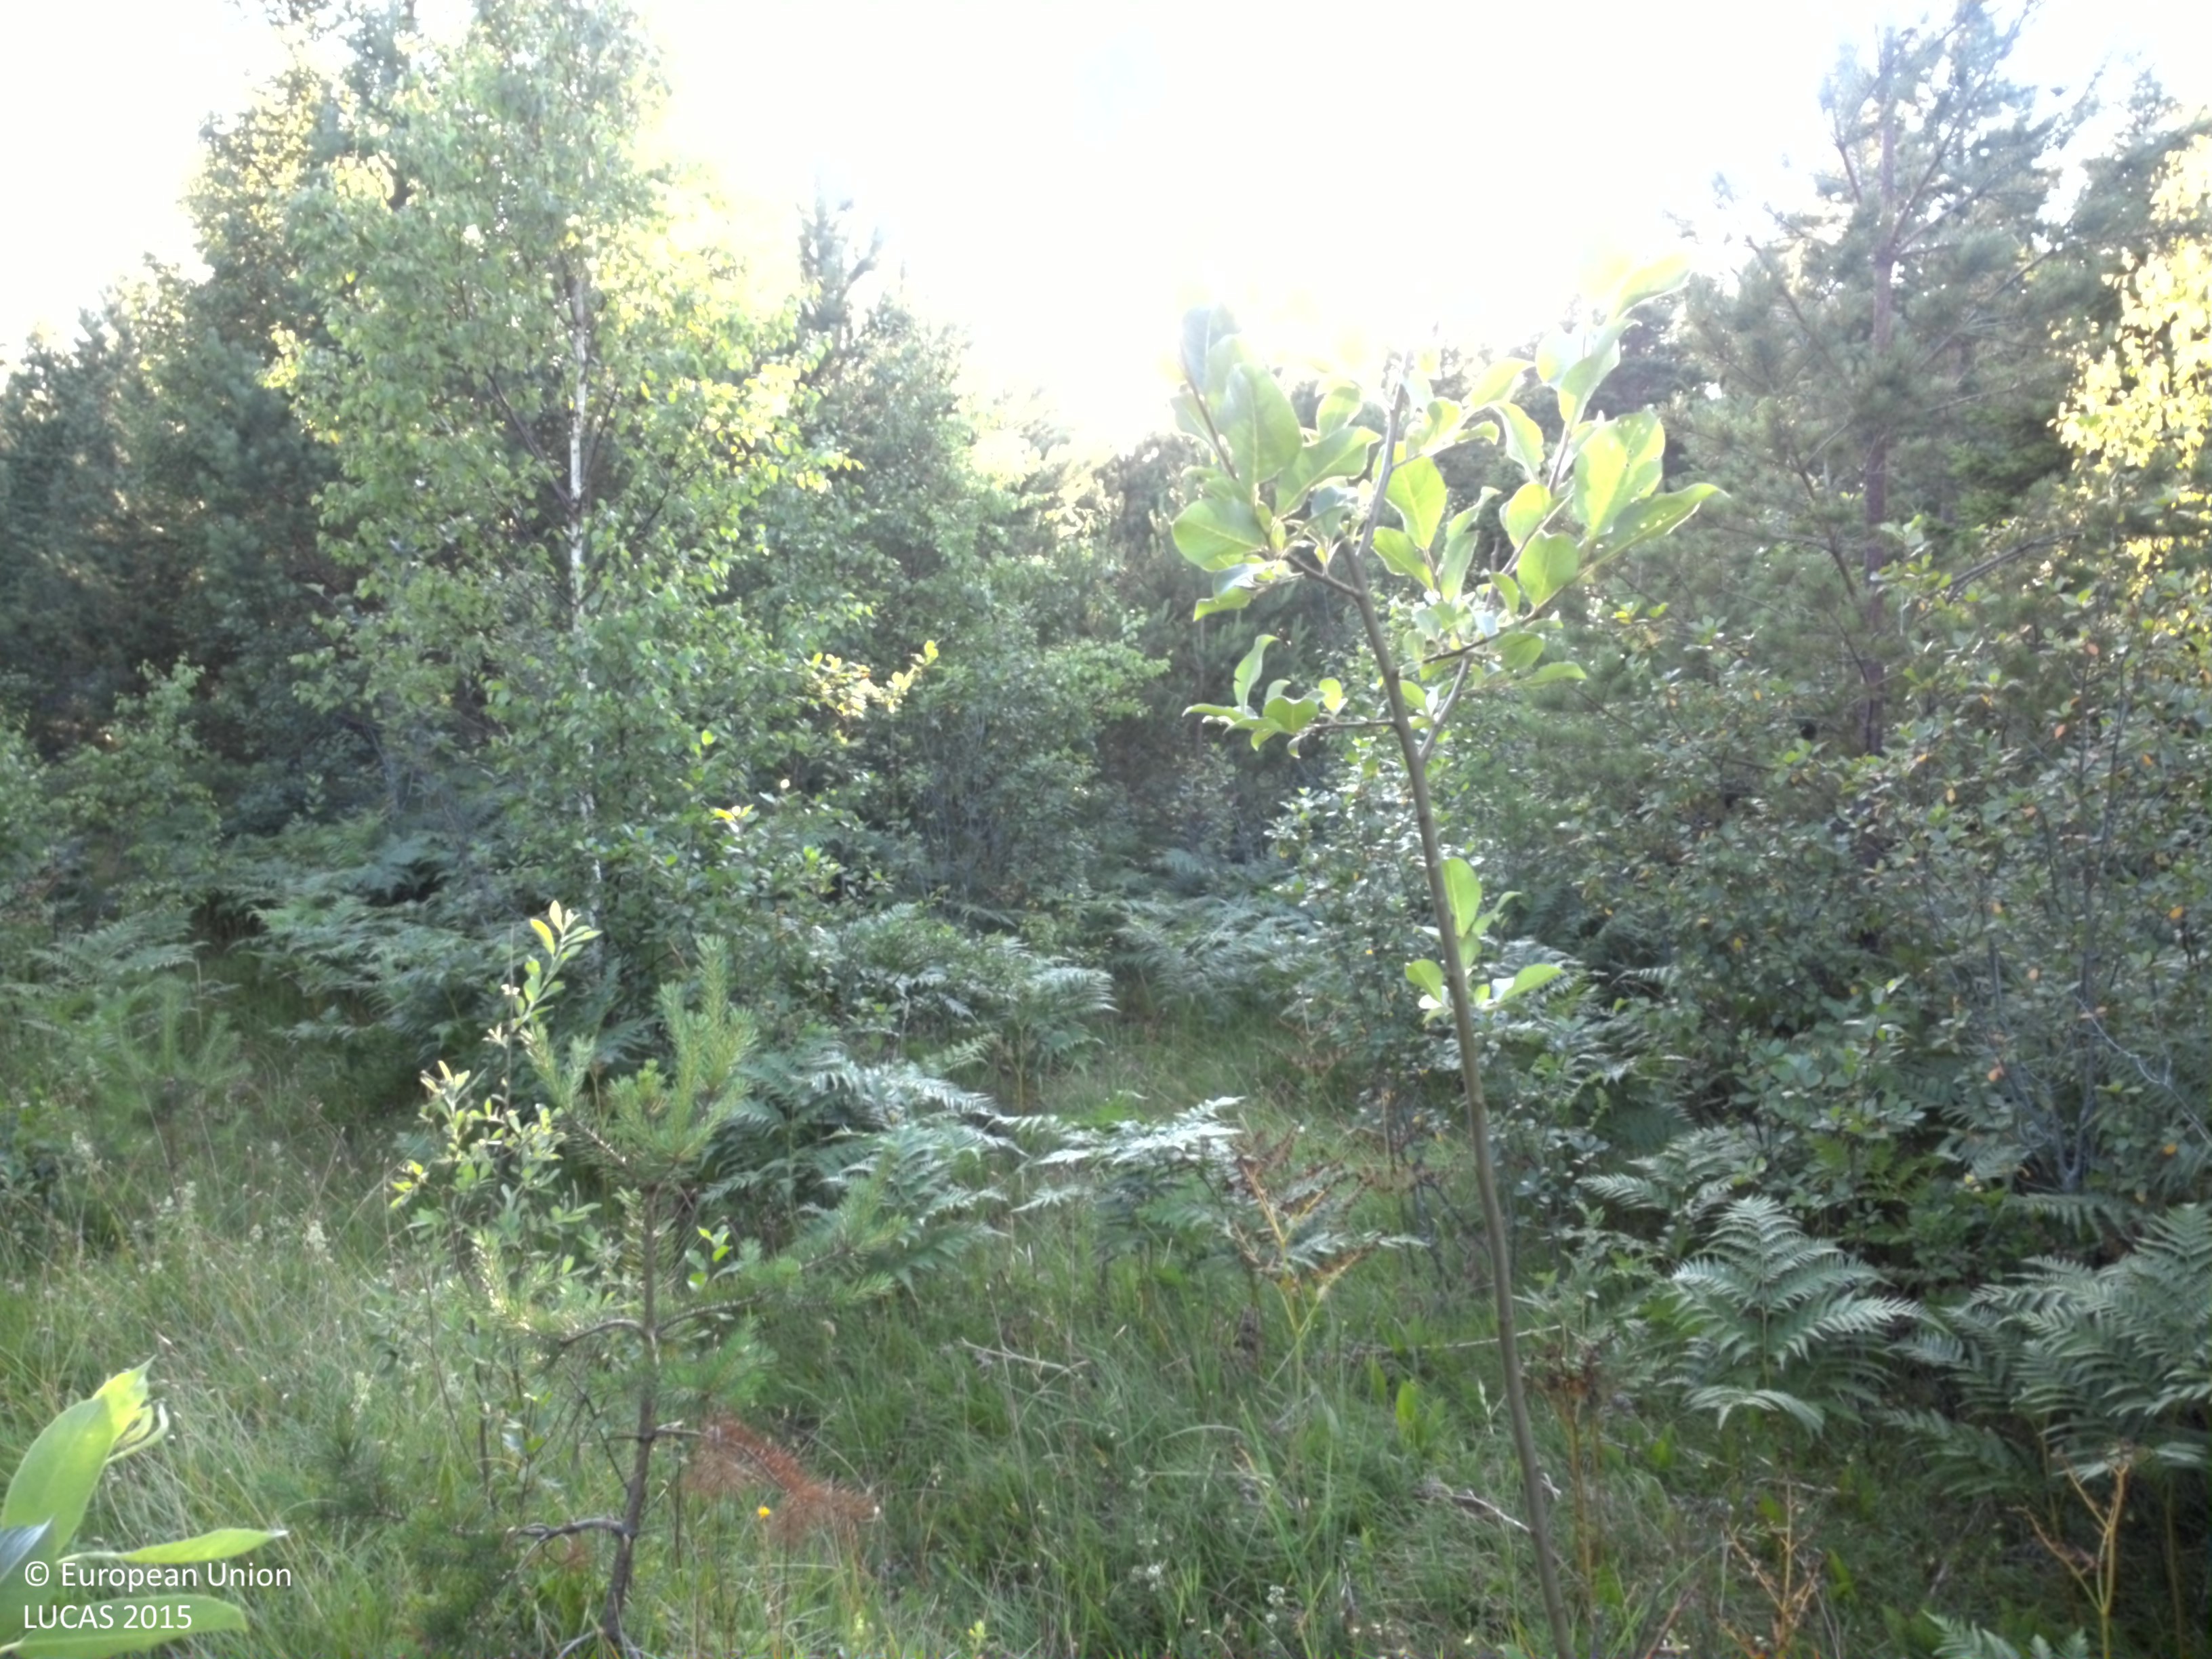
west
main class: Woodland
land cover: Other mixed woodland
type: hemiboreal forest and nemoral coniferous forest and mixed broadleaved-coniferous forest
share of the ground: > 75 %
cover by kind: broadleaved forest trees 35 %, coniferous forest trees 30 %, herbaceous plants 30 %, shrubs 5 %
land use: Forestry
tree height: < 5 m
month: July
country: SE
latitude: 57.4823
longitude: 18.7335
